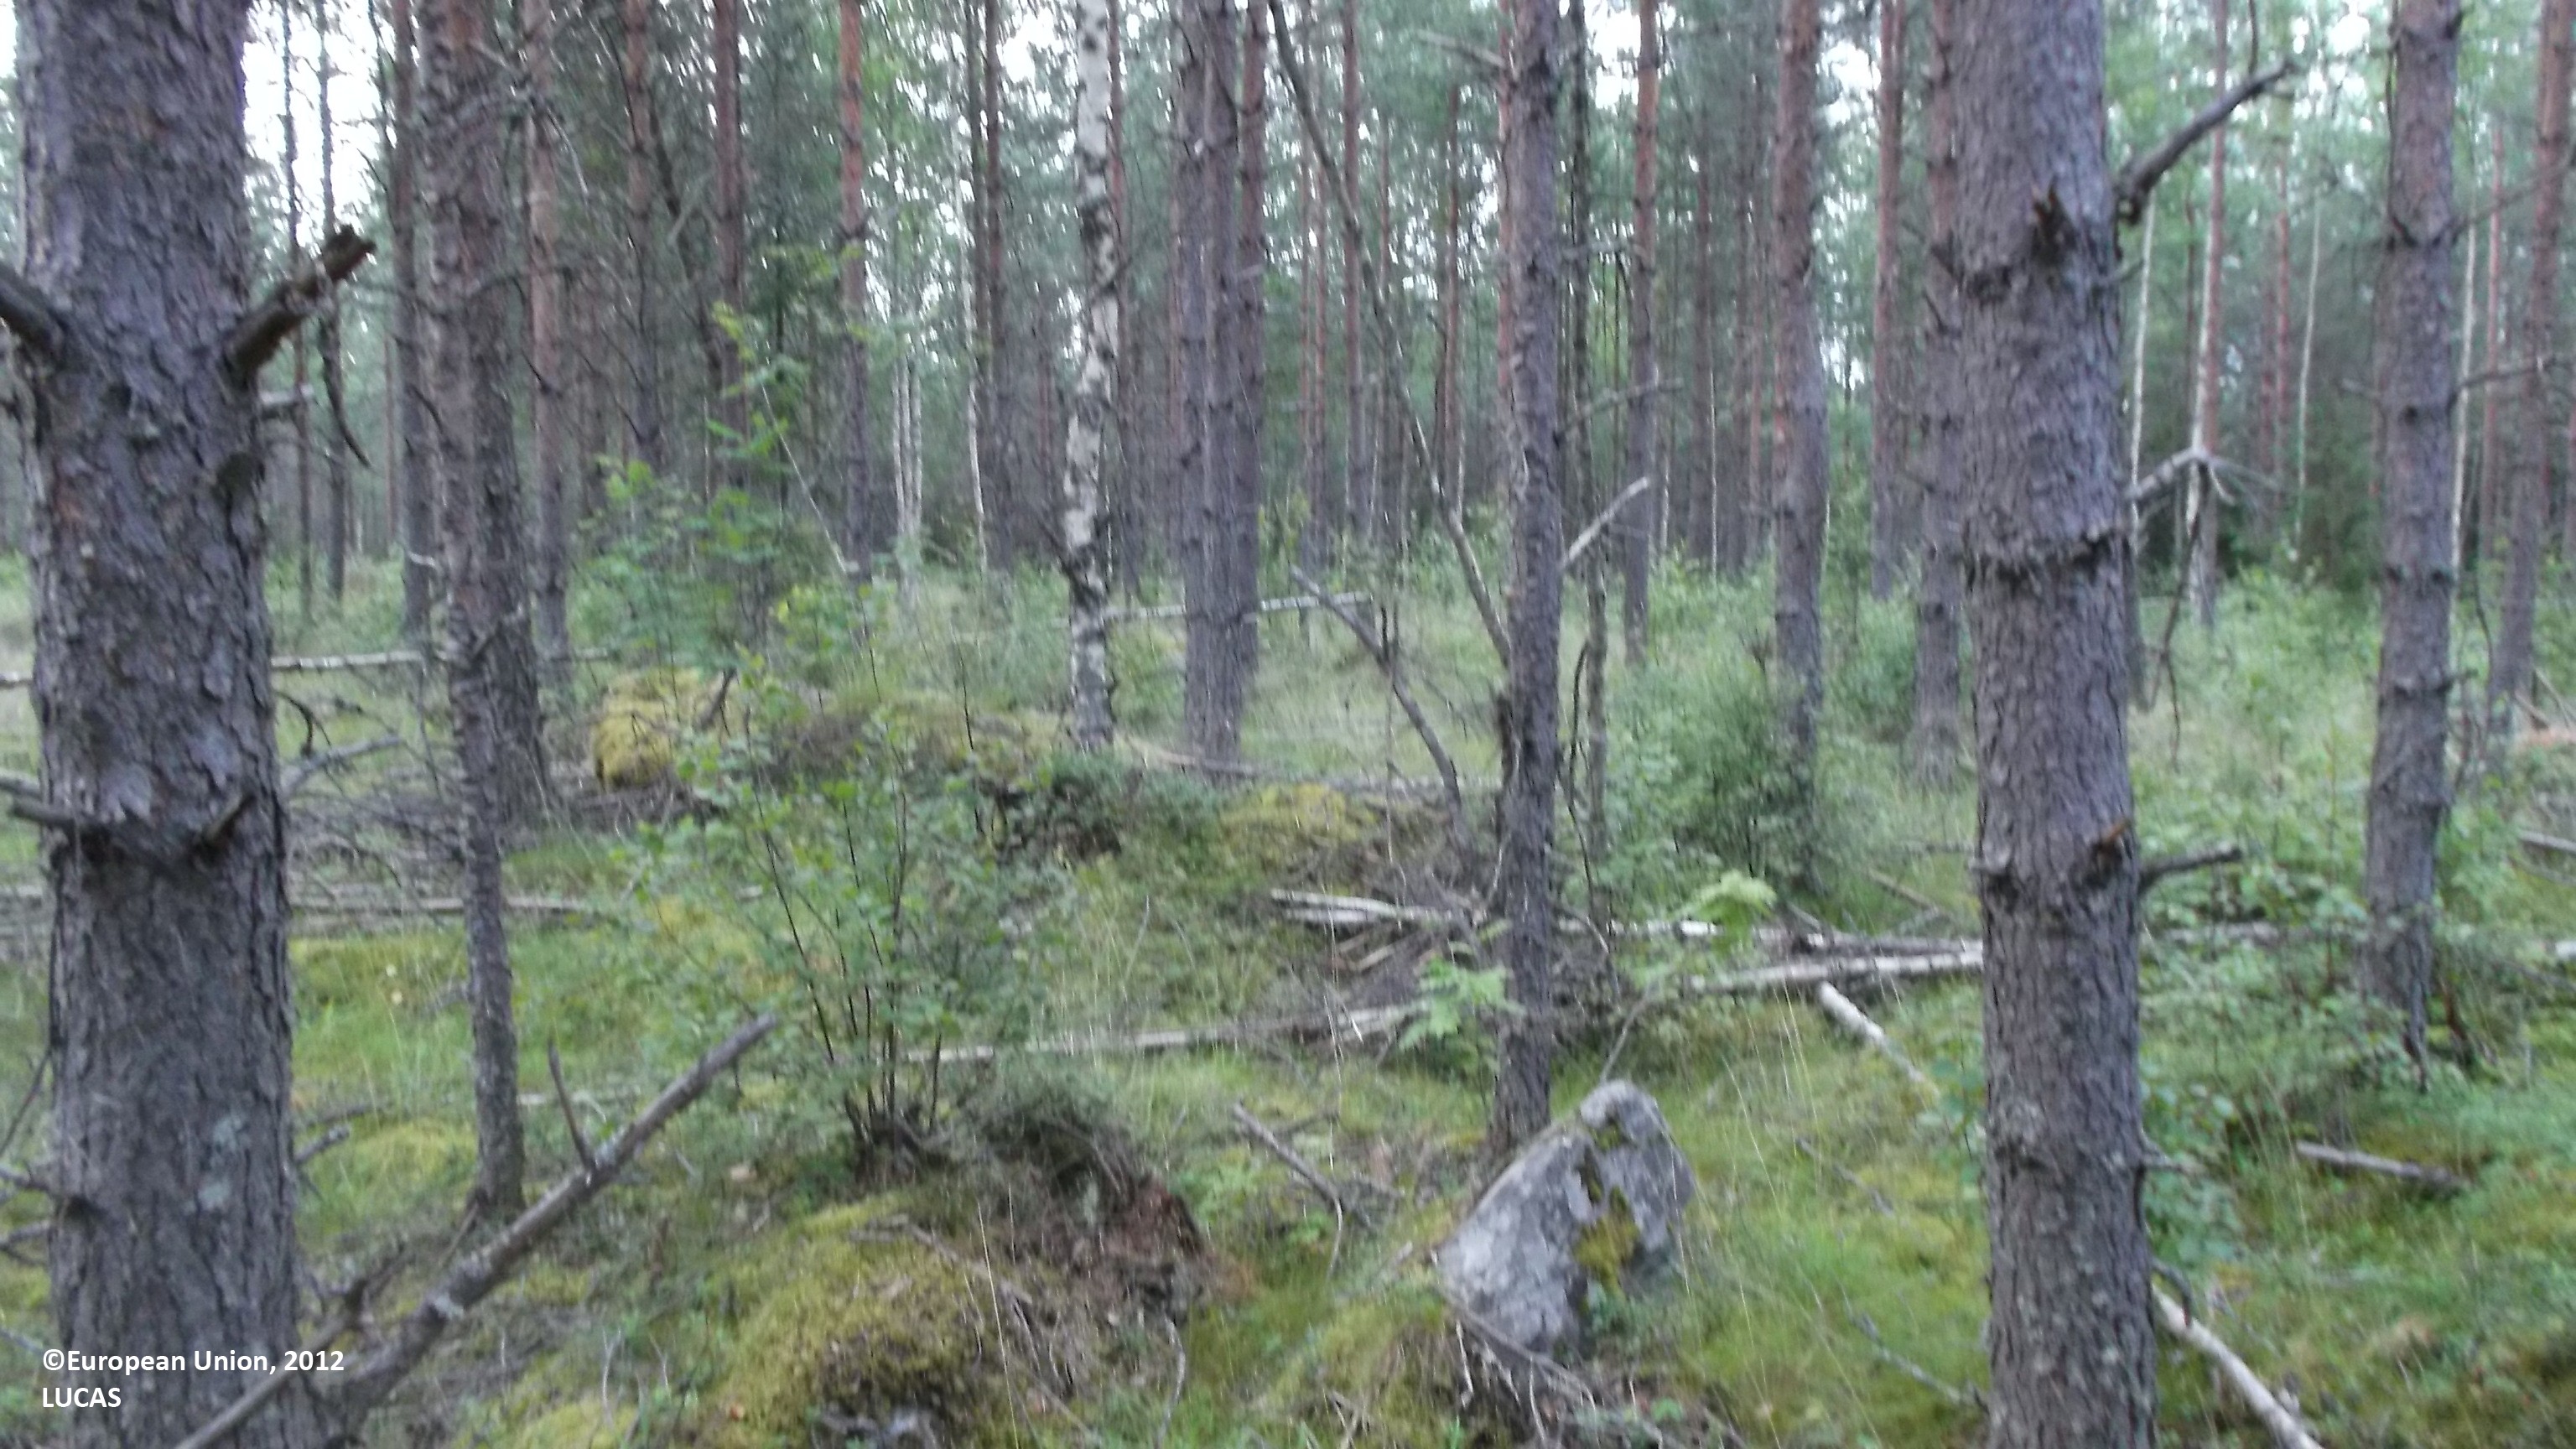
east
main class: Woodland
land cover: Pine dominated mixed woodland
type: boreal forest
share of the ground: 50 - 75 %
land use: Forestry
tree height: > 5 m
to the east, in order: Pine dominated mixed woodland; Other mixed woodland; Pine dominated mixed woodland
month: July
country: FI
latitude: 63.6143
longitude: 23.3084
